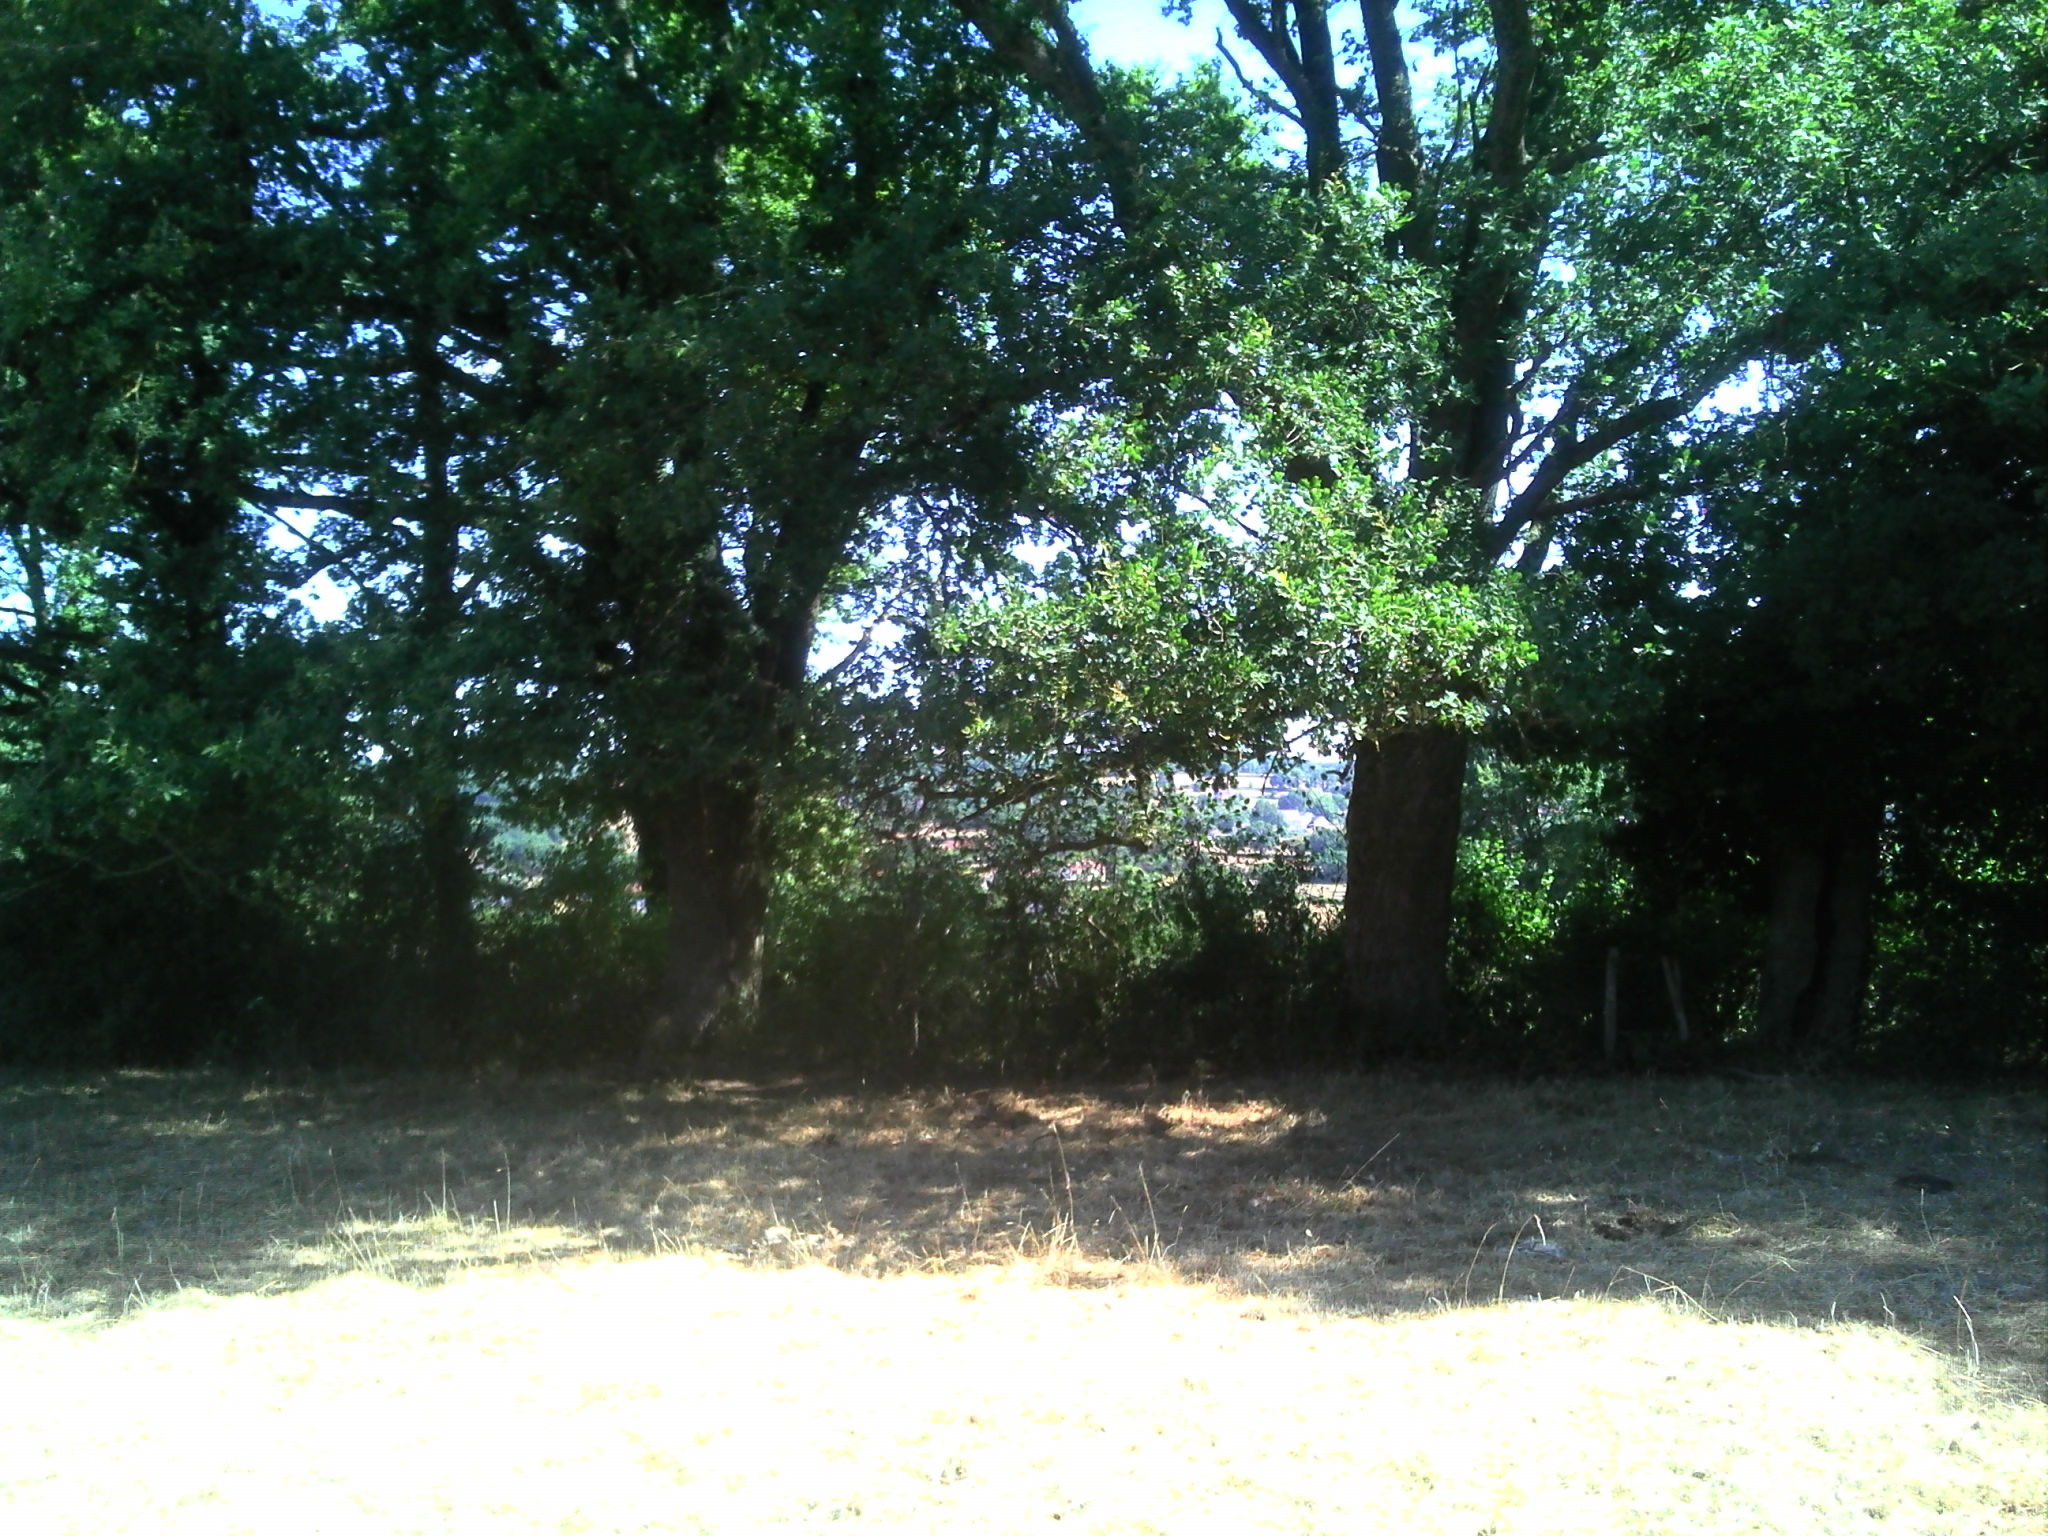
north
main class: Grassland
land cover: Grassland without tree/shrub cover
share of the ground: > 75 %
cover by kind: herbaceous plants 100 %
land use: Agriculture (excluding fallow land and kitchen gardens)
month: August
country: FR
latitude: 46.6555
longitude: 4.3948
